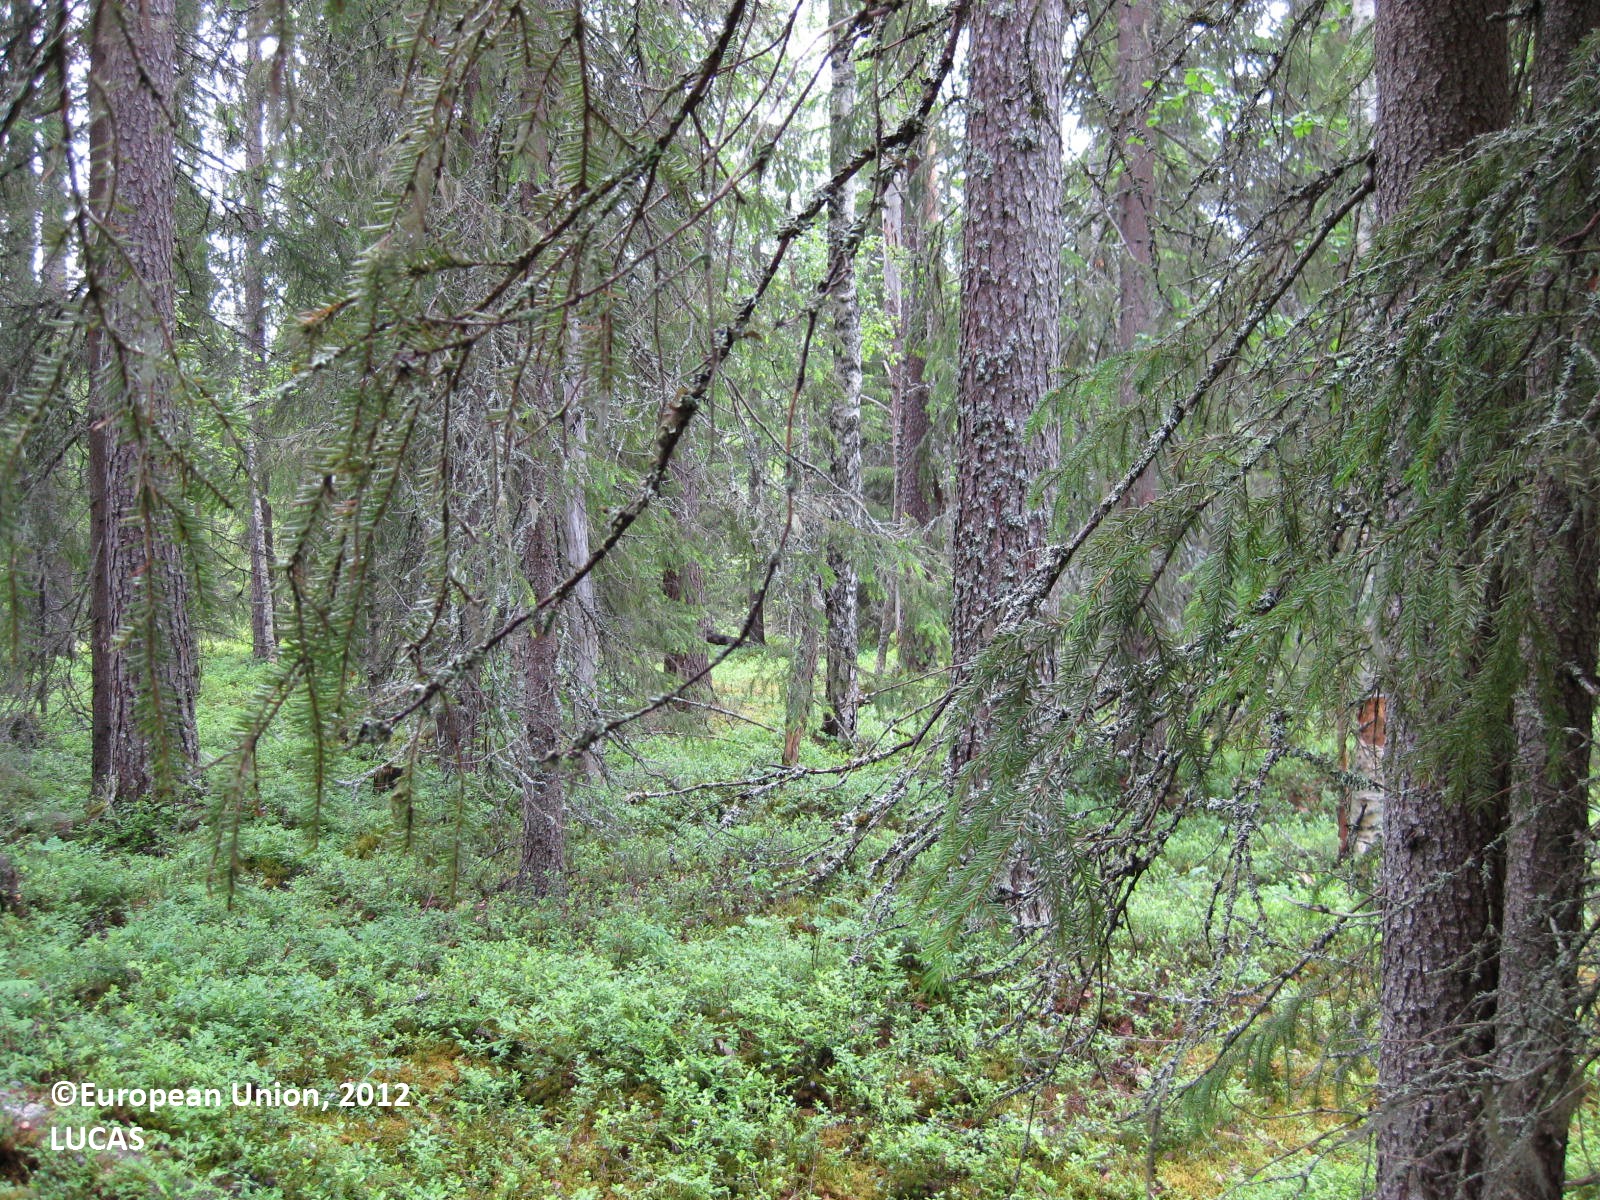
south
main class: Woodland
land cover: Spruce dominated mixed woodland
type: boreal forest
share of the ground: > 75 %
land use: Forestry
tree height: > 5 m
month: July
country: FI
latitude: 65.4657
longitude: 28.3067
